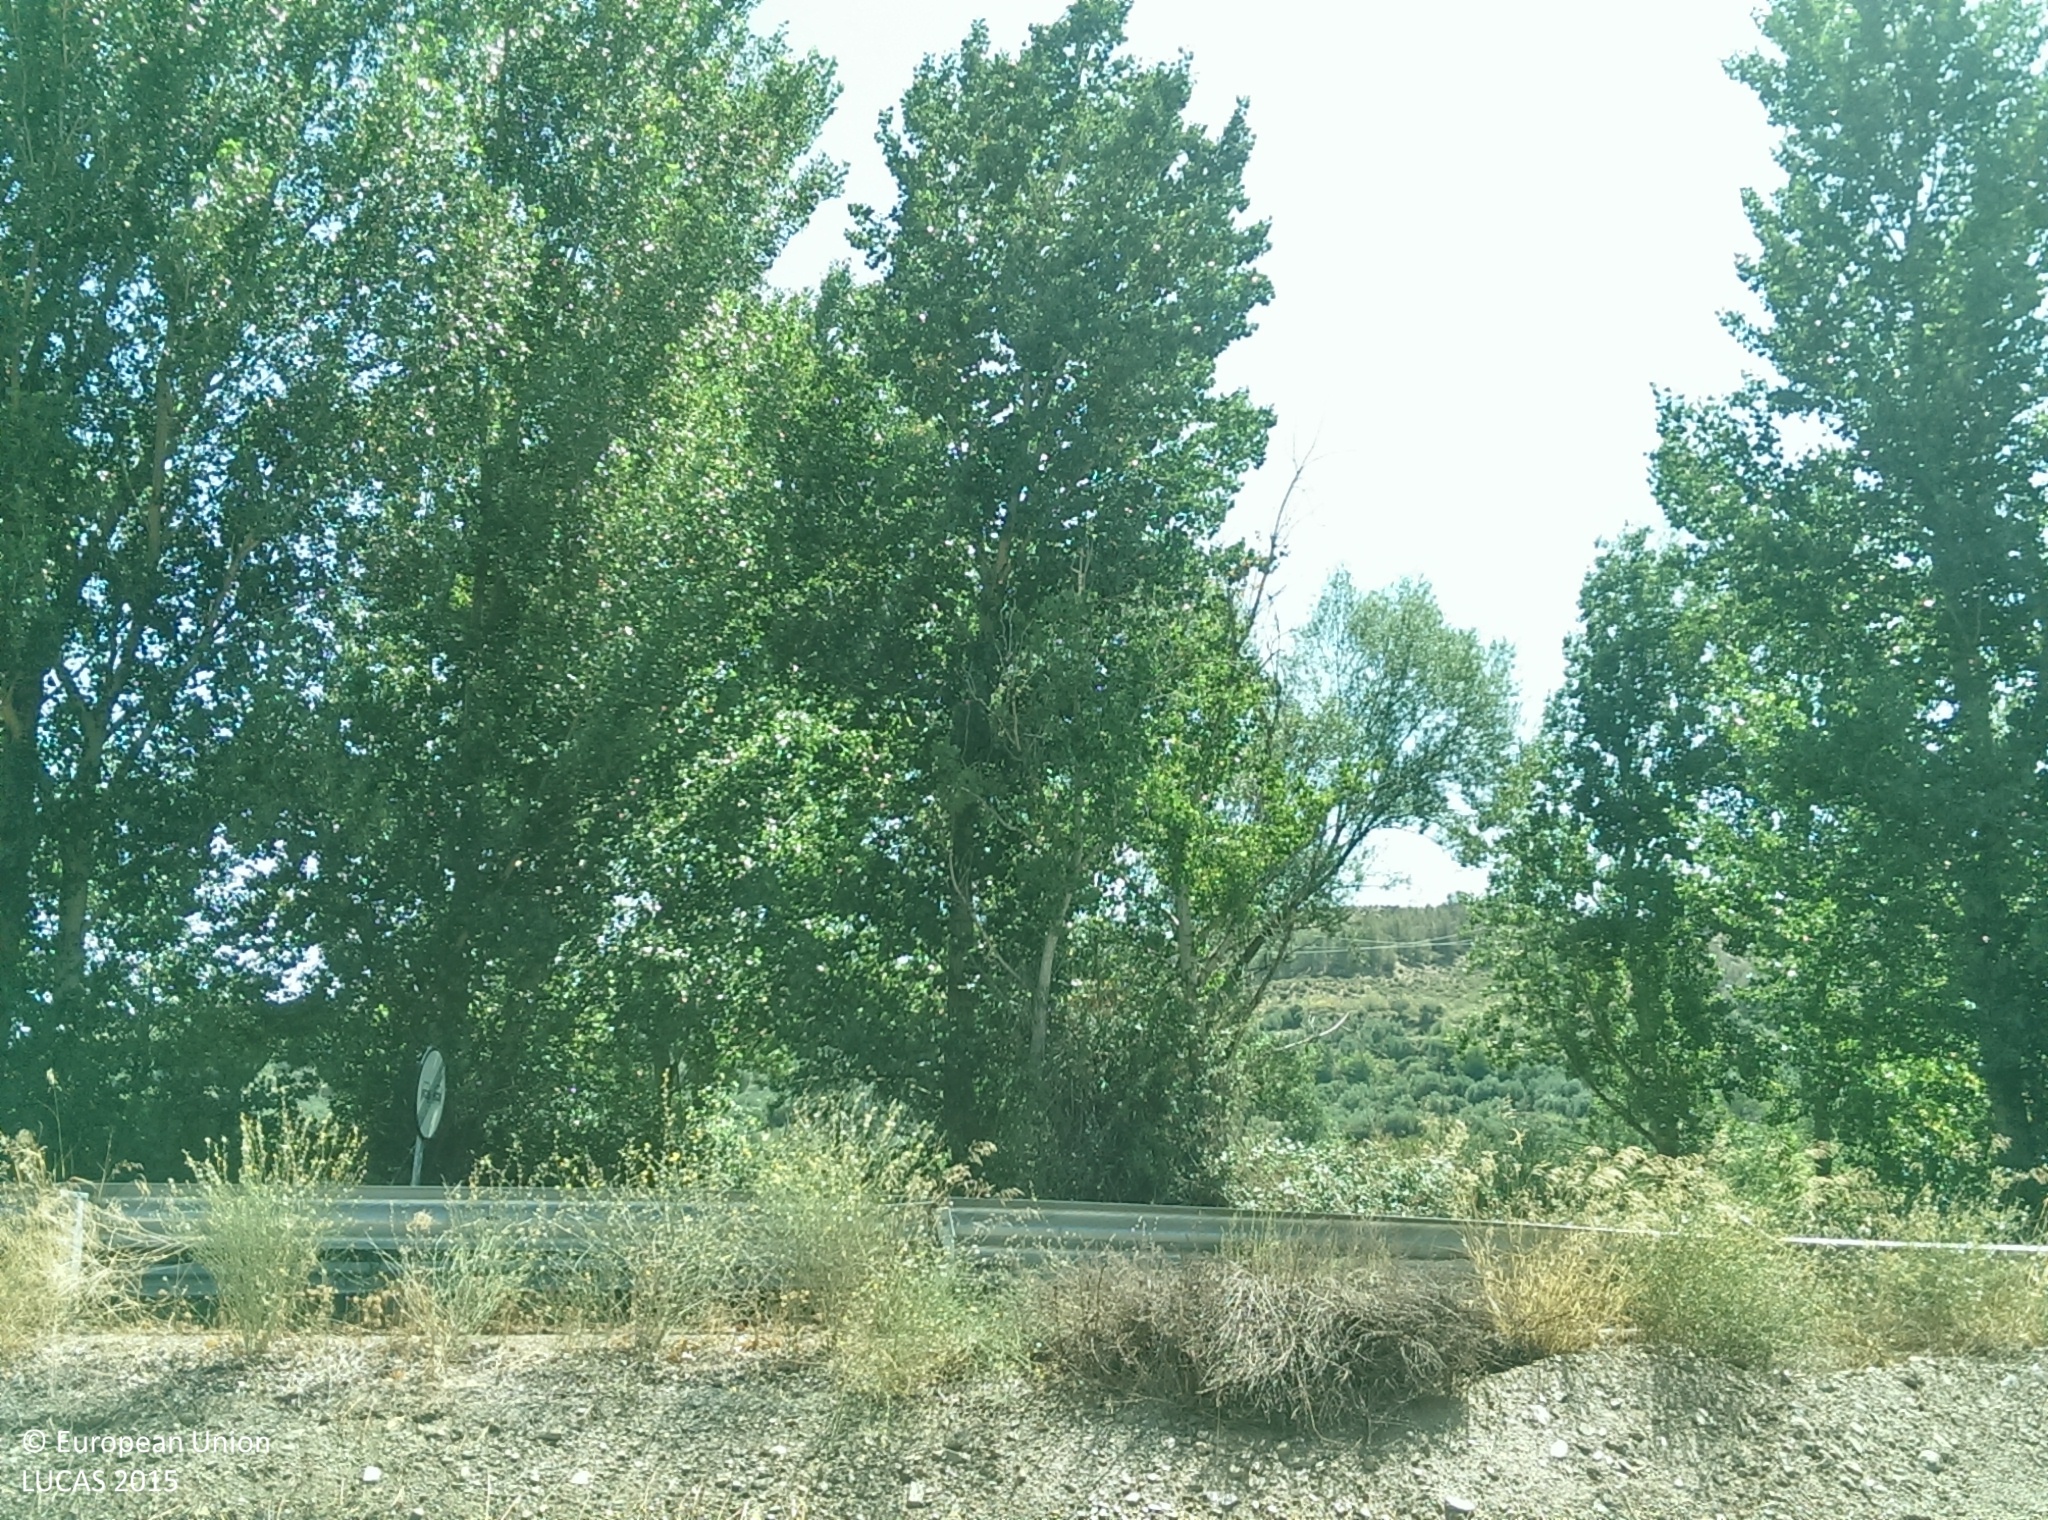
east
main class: Grassland
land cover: Spontaneously vegetated surfaces
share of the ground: 50 - 75 %
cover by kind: herbaceous plants 60 %, unconsolidated bare surface 40 %
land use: Fallow land
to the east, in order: Spontaneously vegetated surfaces; Electric lines; Grass margins; Paved roads, cycling and walking lanes; Broadleaved woodland; Rivers and streams; Broadleaved woodland; Ditches and canals; Grass margins; Nuts trees; Olive groves; Dry stone walls; Tracks; Dry stone walls; Fences; Vineyards; Electric lines; Fences; Tracks
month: July
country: ES
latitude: 37.3004
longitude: -3.1983
